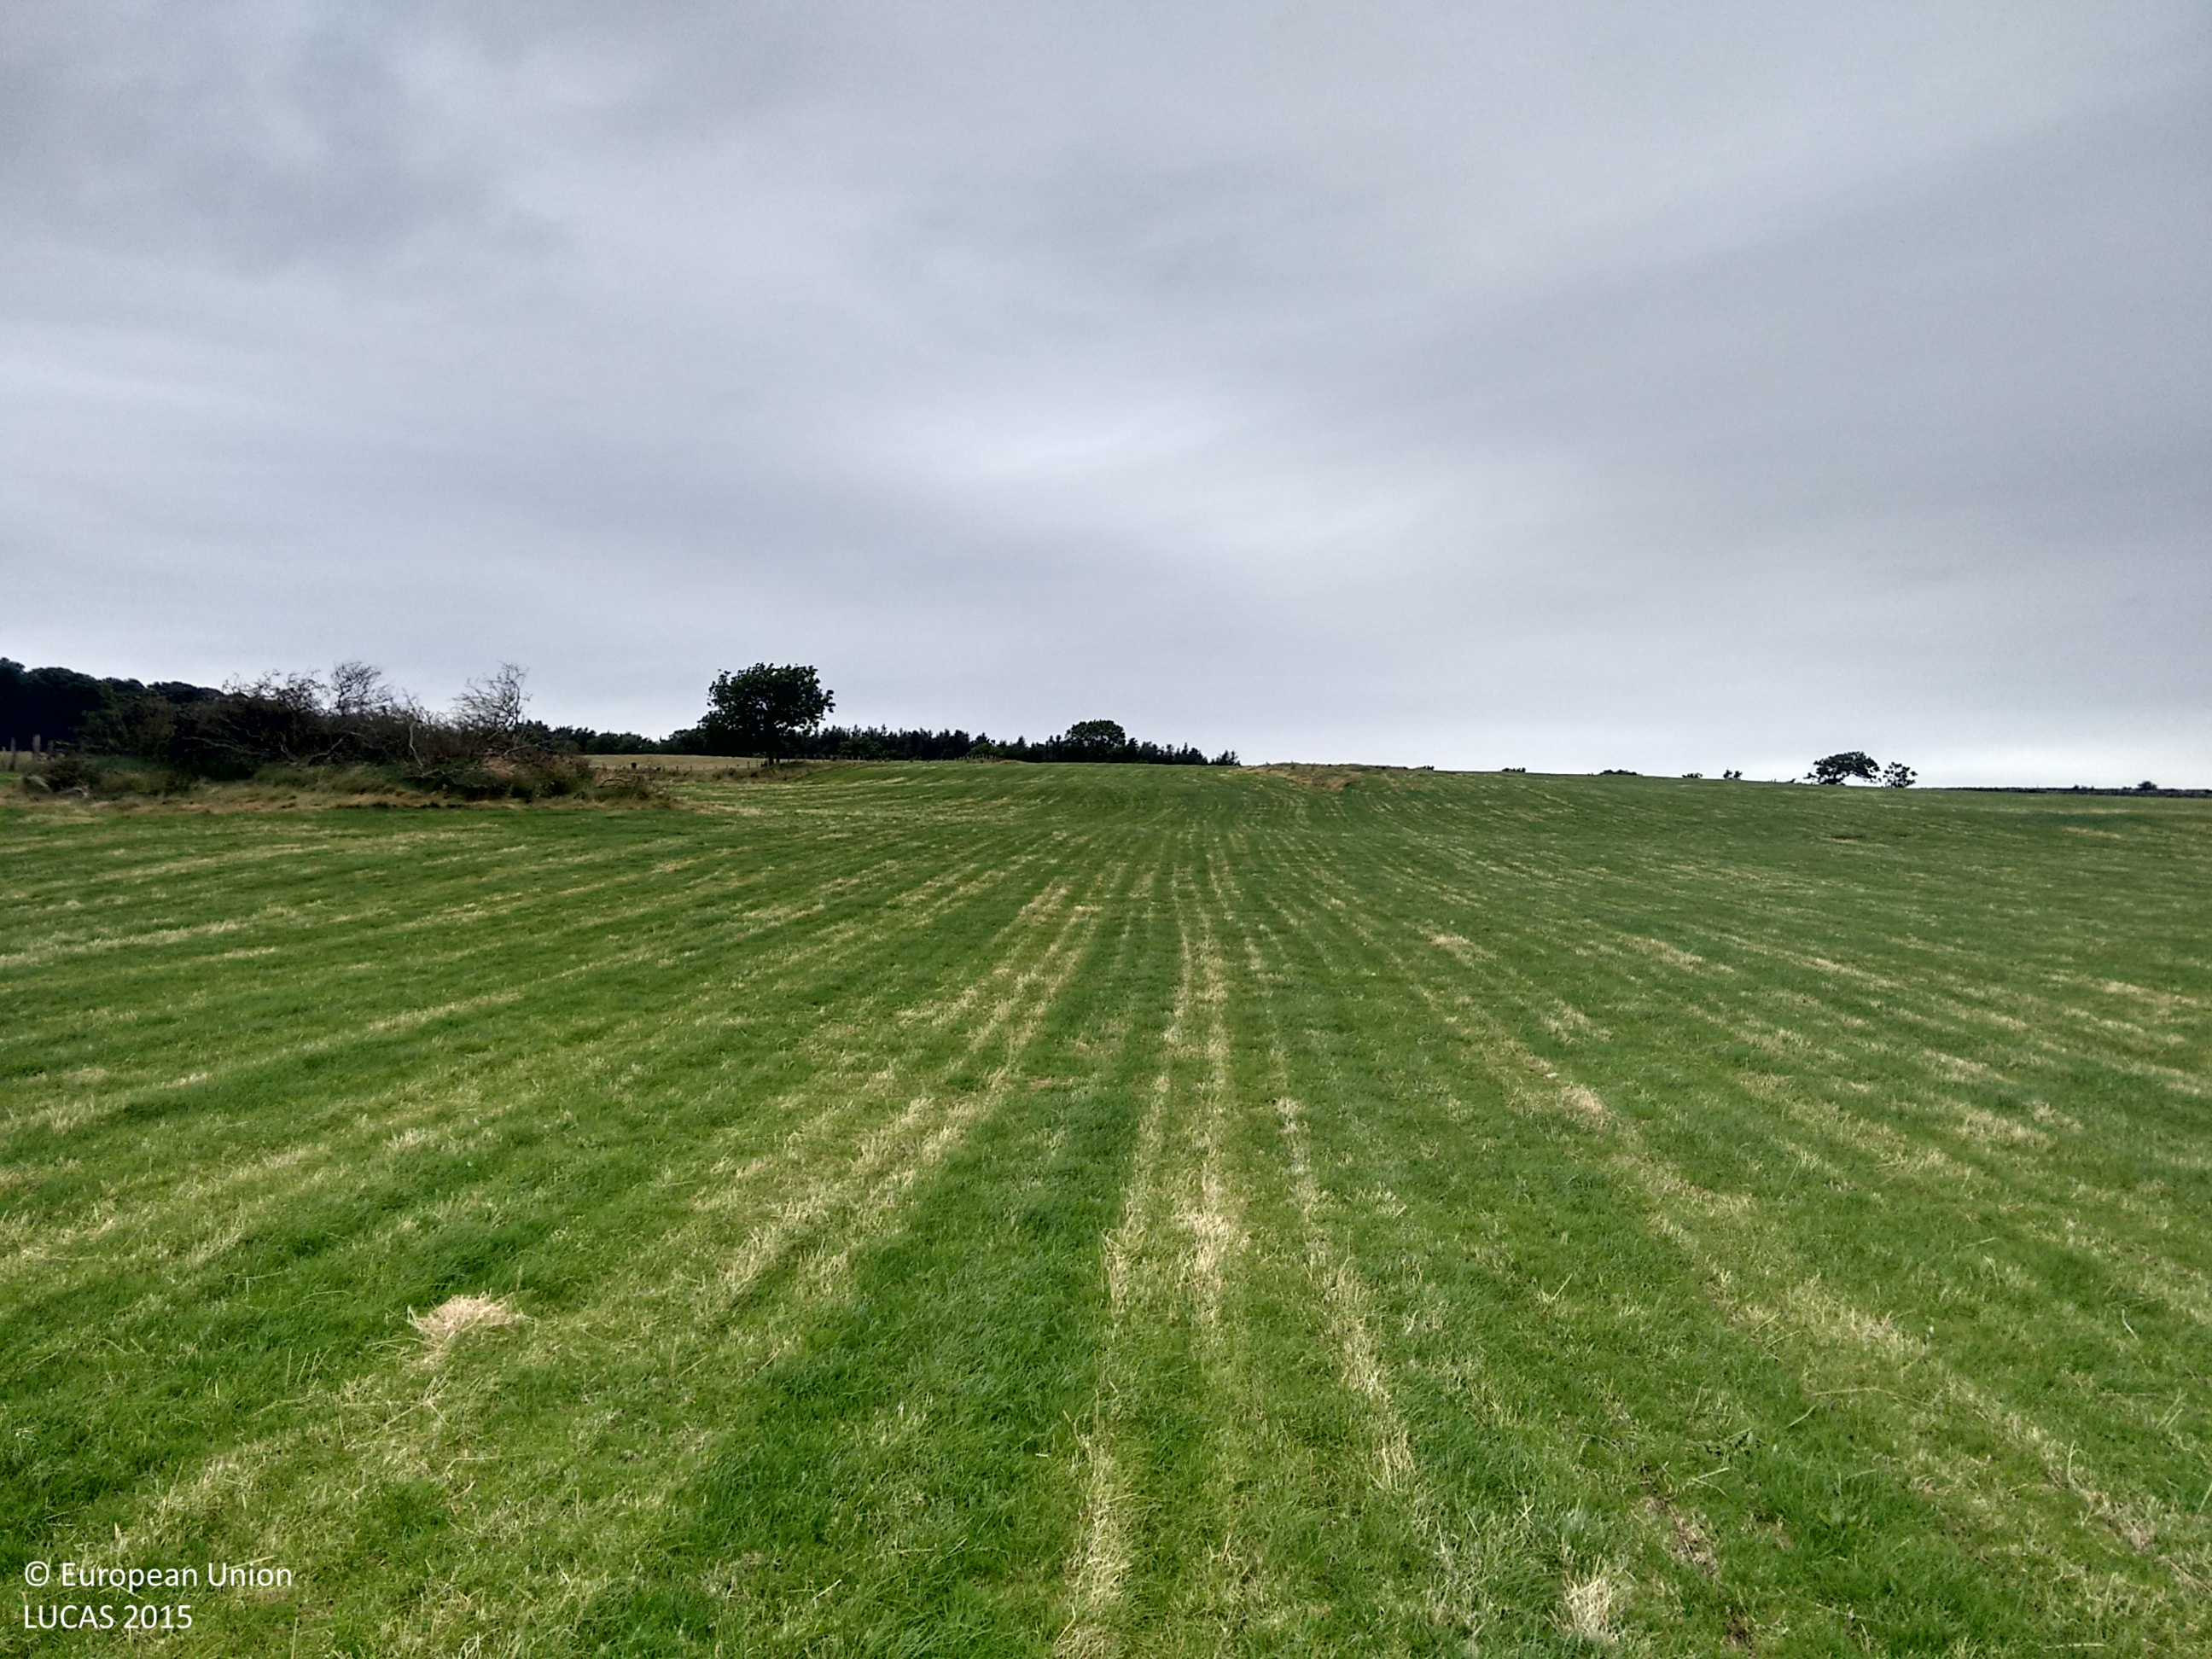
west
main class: Grassland
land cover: Grassland without tree/shrub cover
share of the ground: > 75 %
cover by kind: herbaceous plants 100 %
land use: Agriculture (excluding fallow land and kitchen gardens)
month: August
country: GB
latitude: 53.2953
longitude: -4.4622
